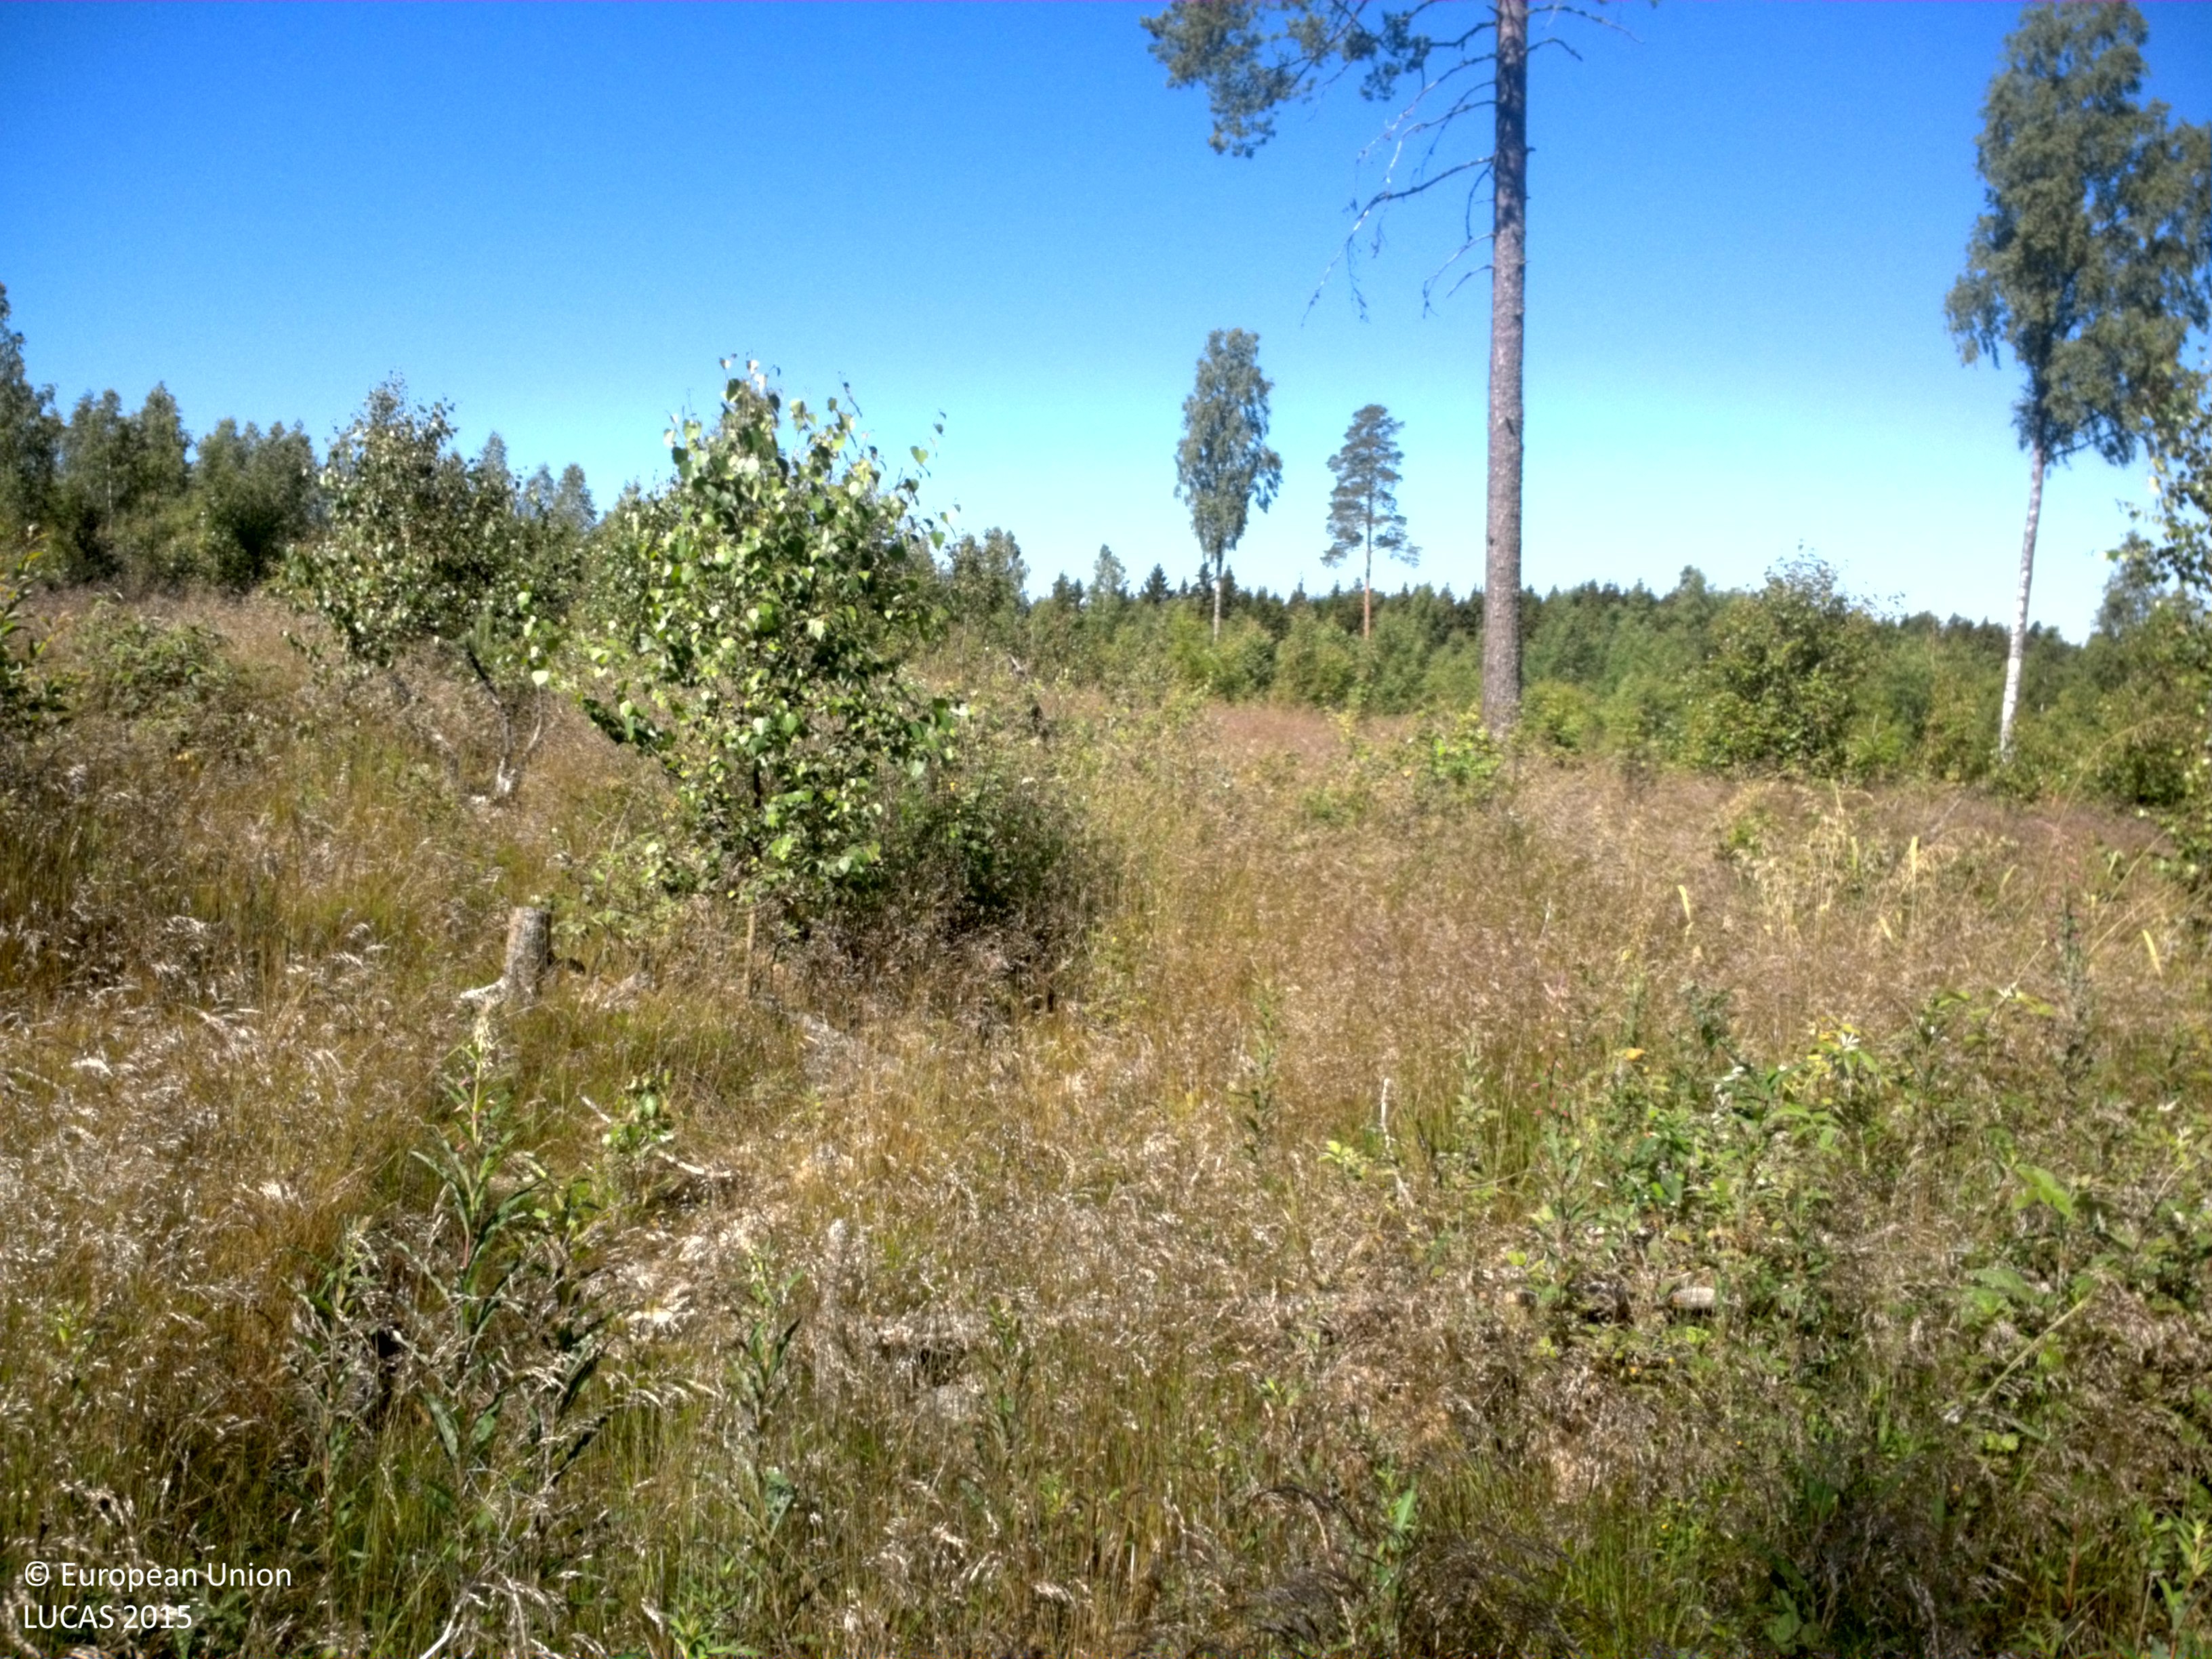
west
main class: Woodland
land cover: Broadleaved woodland
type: hemiboreal forest and nemoral coniferous forest and mixed broadleaved-coniferous forest
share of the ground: 10 - 25 %
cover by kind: herbaceous plants 70 %, broadleaved forest trees 20 %, coniferous forest trees 5 %, consolidated bare surface 5 %
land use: Forestry
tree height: < 5 m
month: July
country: SE
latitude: 60.0384
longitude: 16.7225
